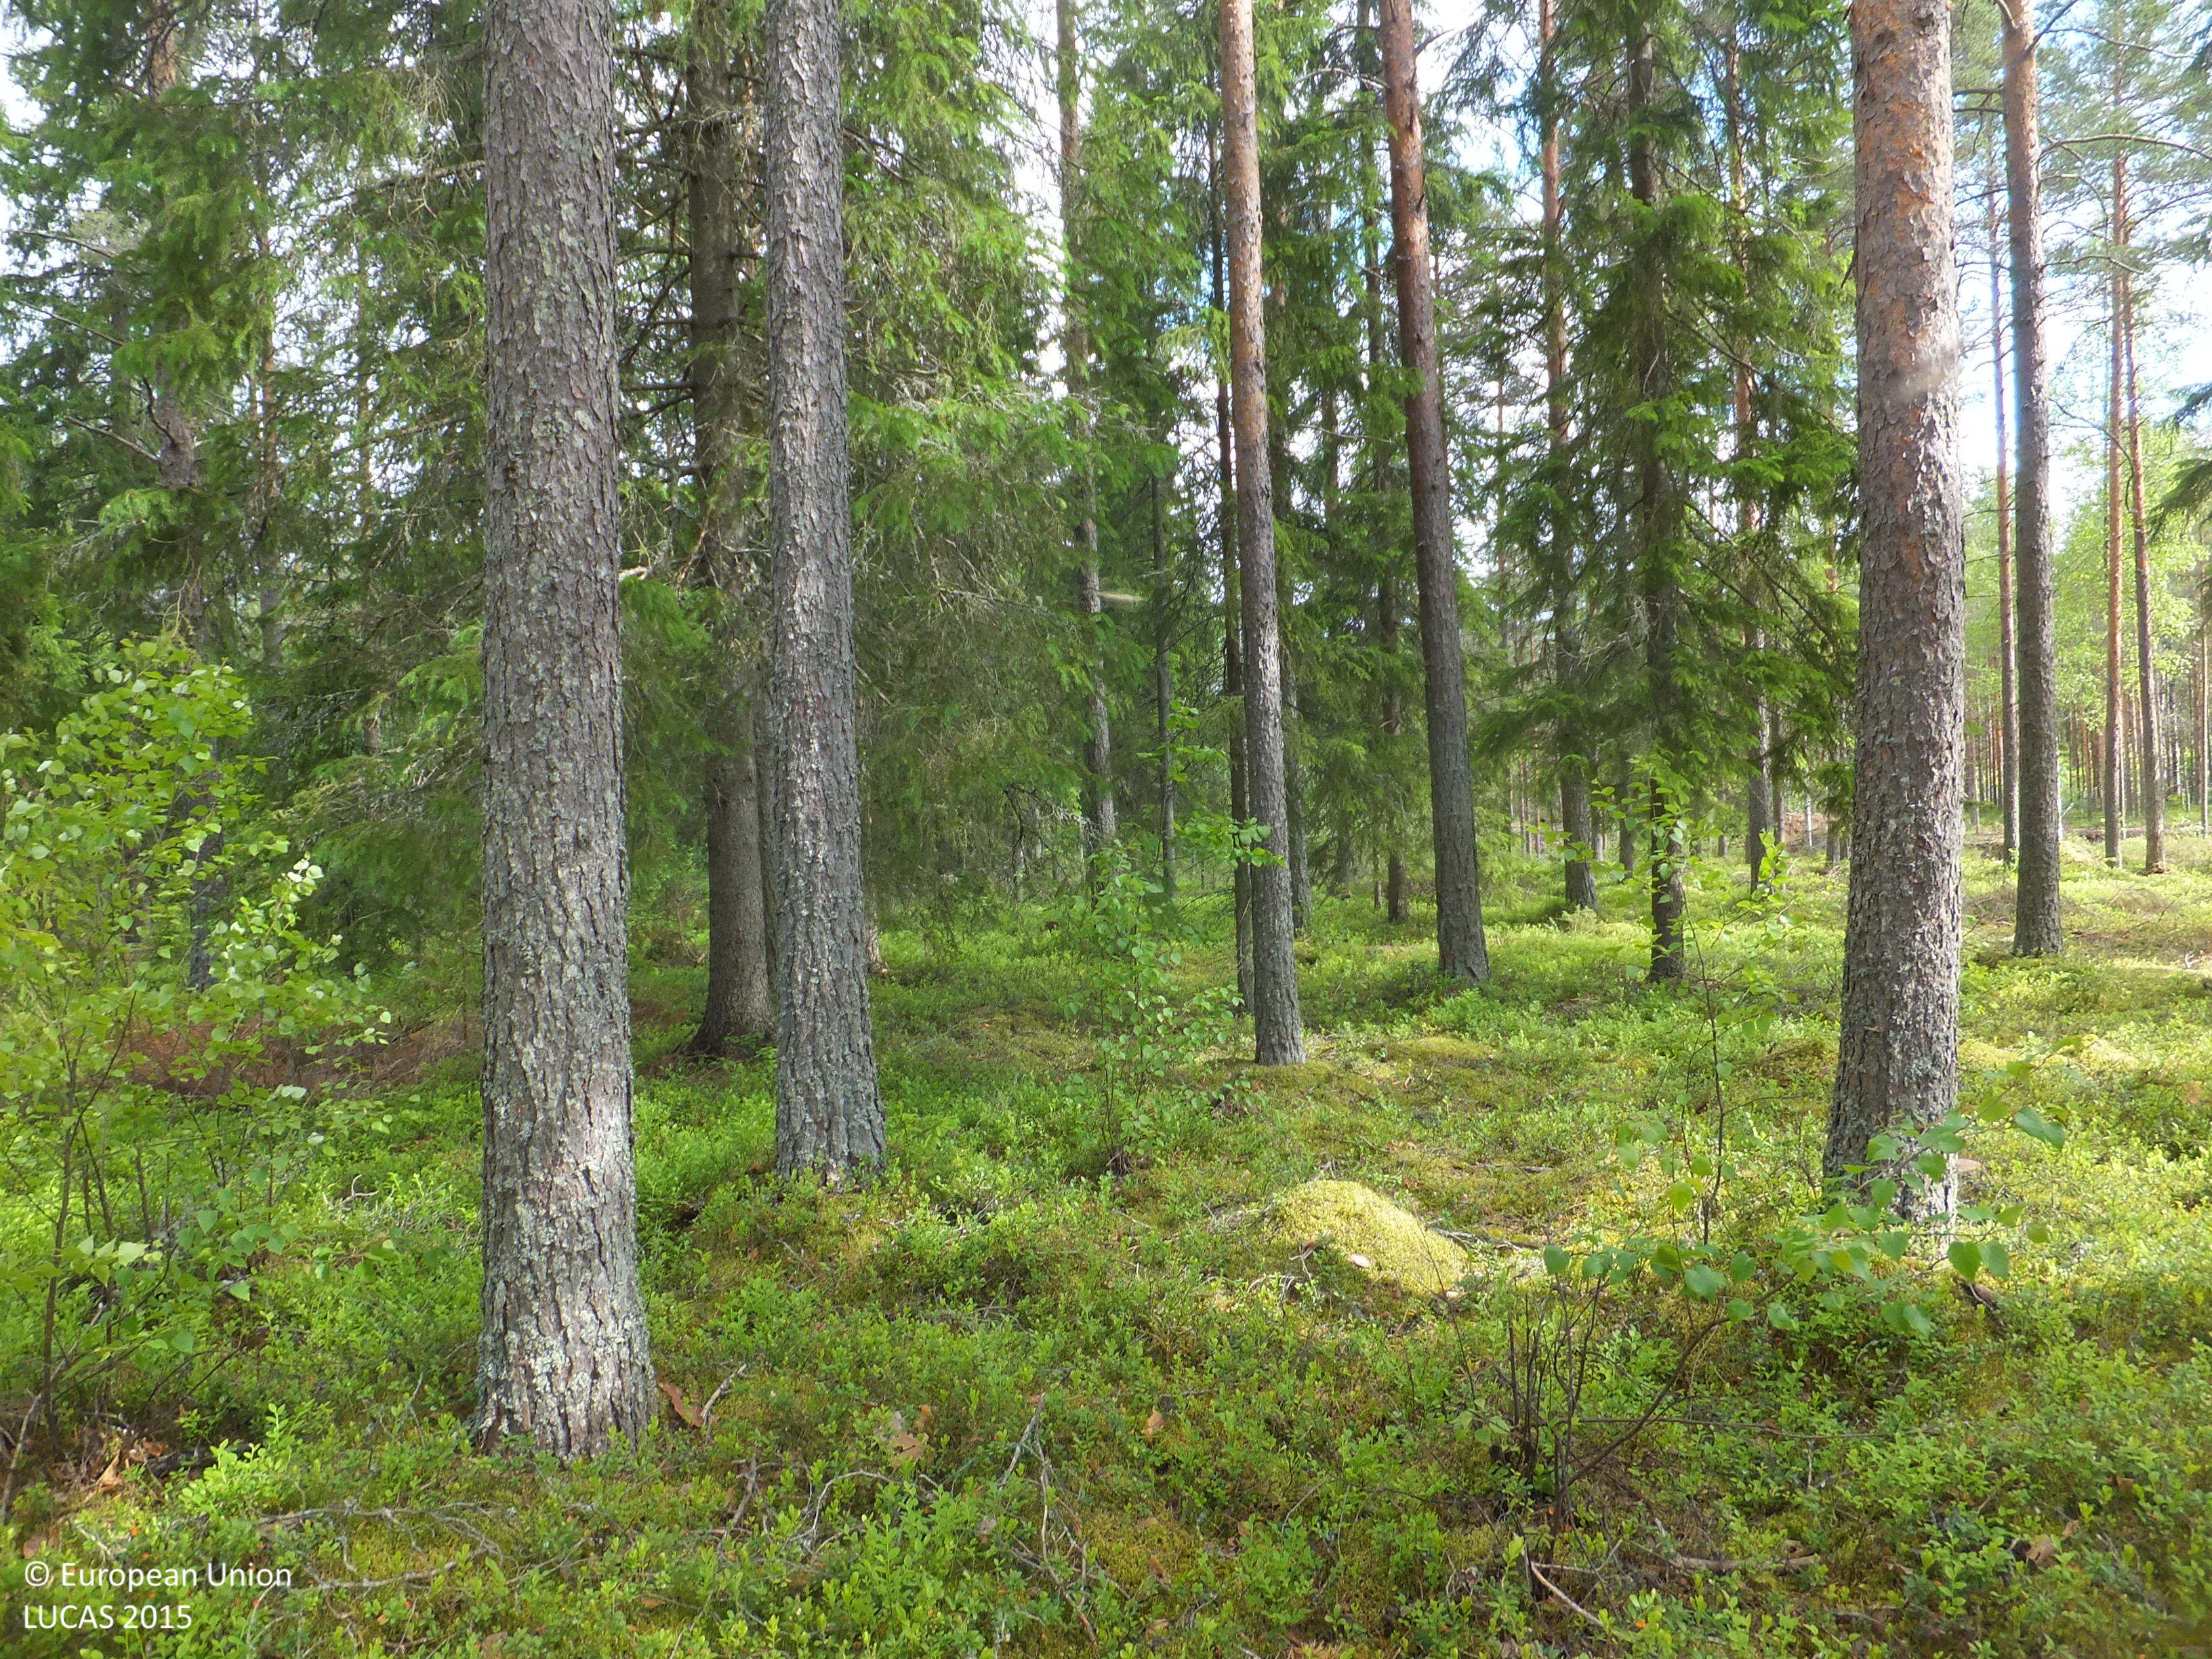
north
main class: Woodland
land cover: Pine dominated coniferous woodland
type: boreal forest
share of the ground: > 75 %
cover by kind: coniferous forest trees 80 %, shrubs 10 %, broadleaved forest trees 5 %, lichens and mosses 5 %
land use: Forestry
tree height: > 5 m
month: June
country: FI
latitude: 63.3961
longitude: 24.1041
